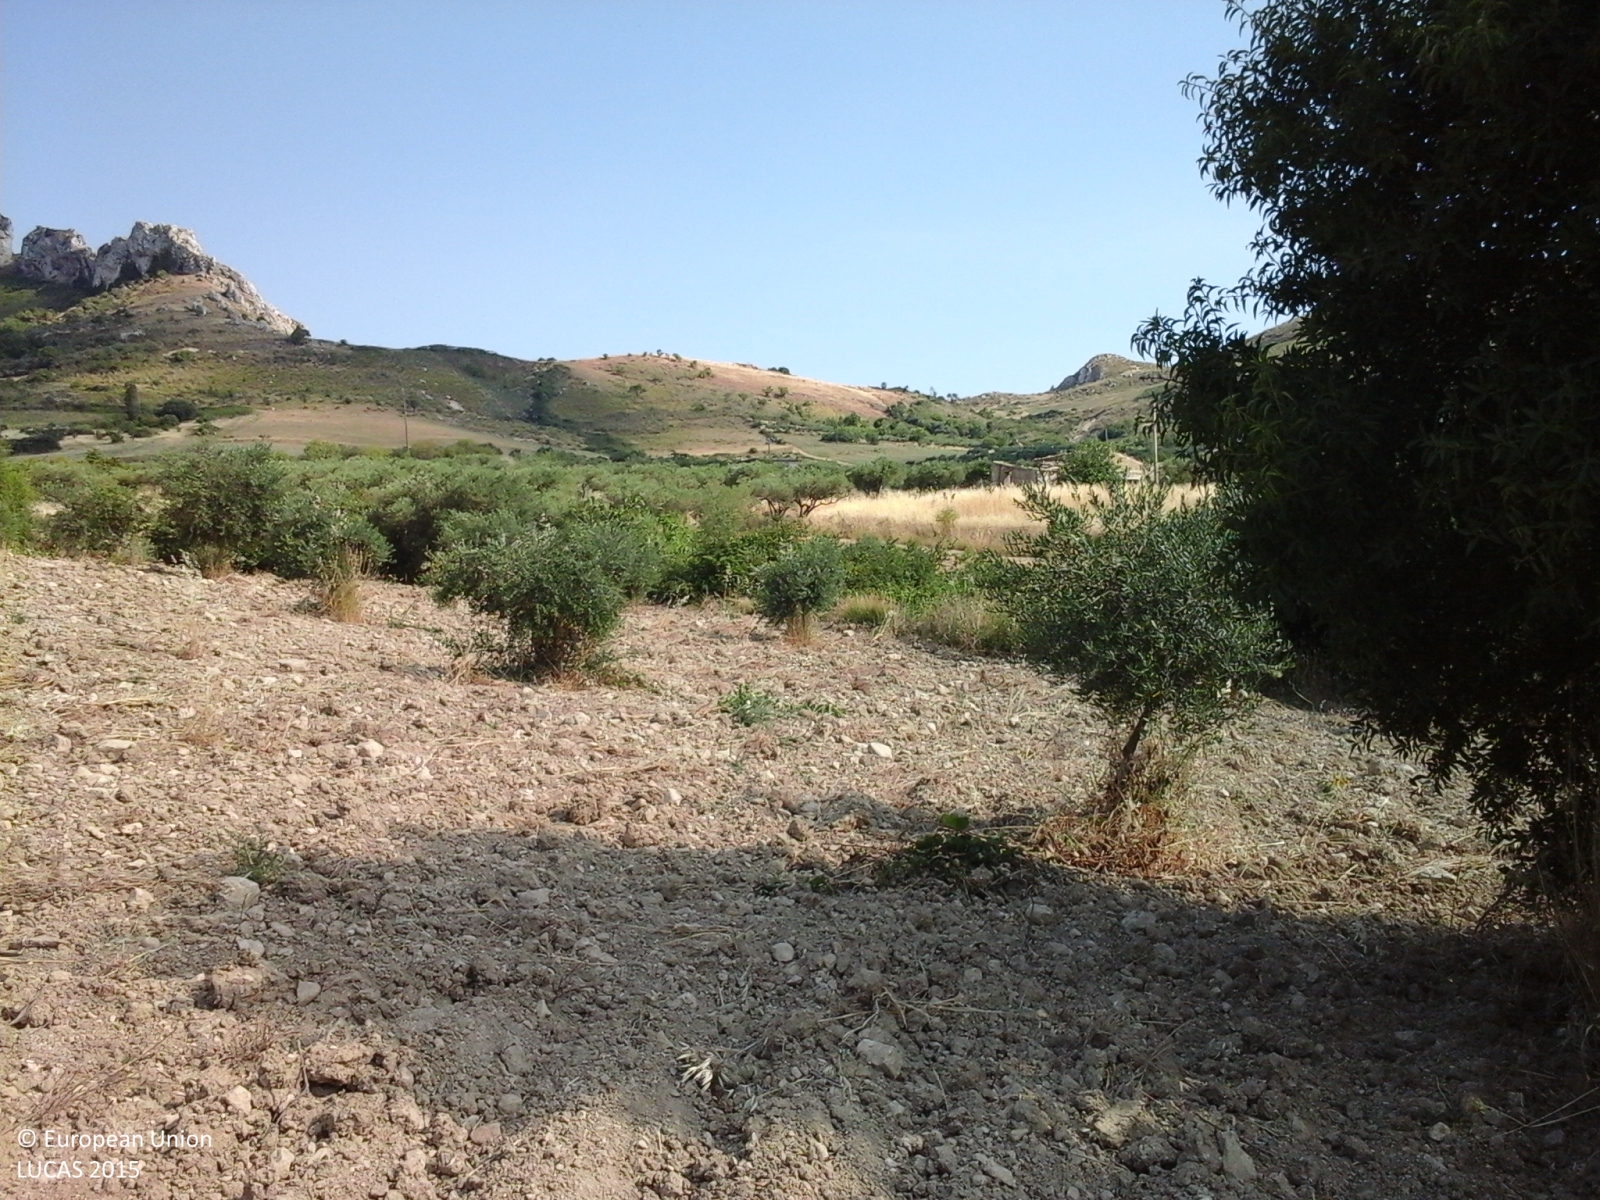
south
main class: Cropland
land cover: Olive groves
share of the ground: 25 - 50 %
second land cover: Other bare soil
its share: > 75 %
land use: Agriculture (excluding fallow land and kitchen gardens)
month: July
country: IT
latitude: 37.5854
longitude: 13.1807
